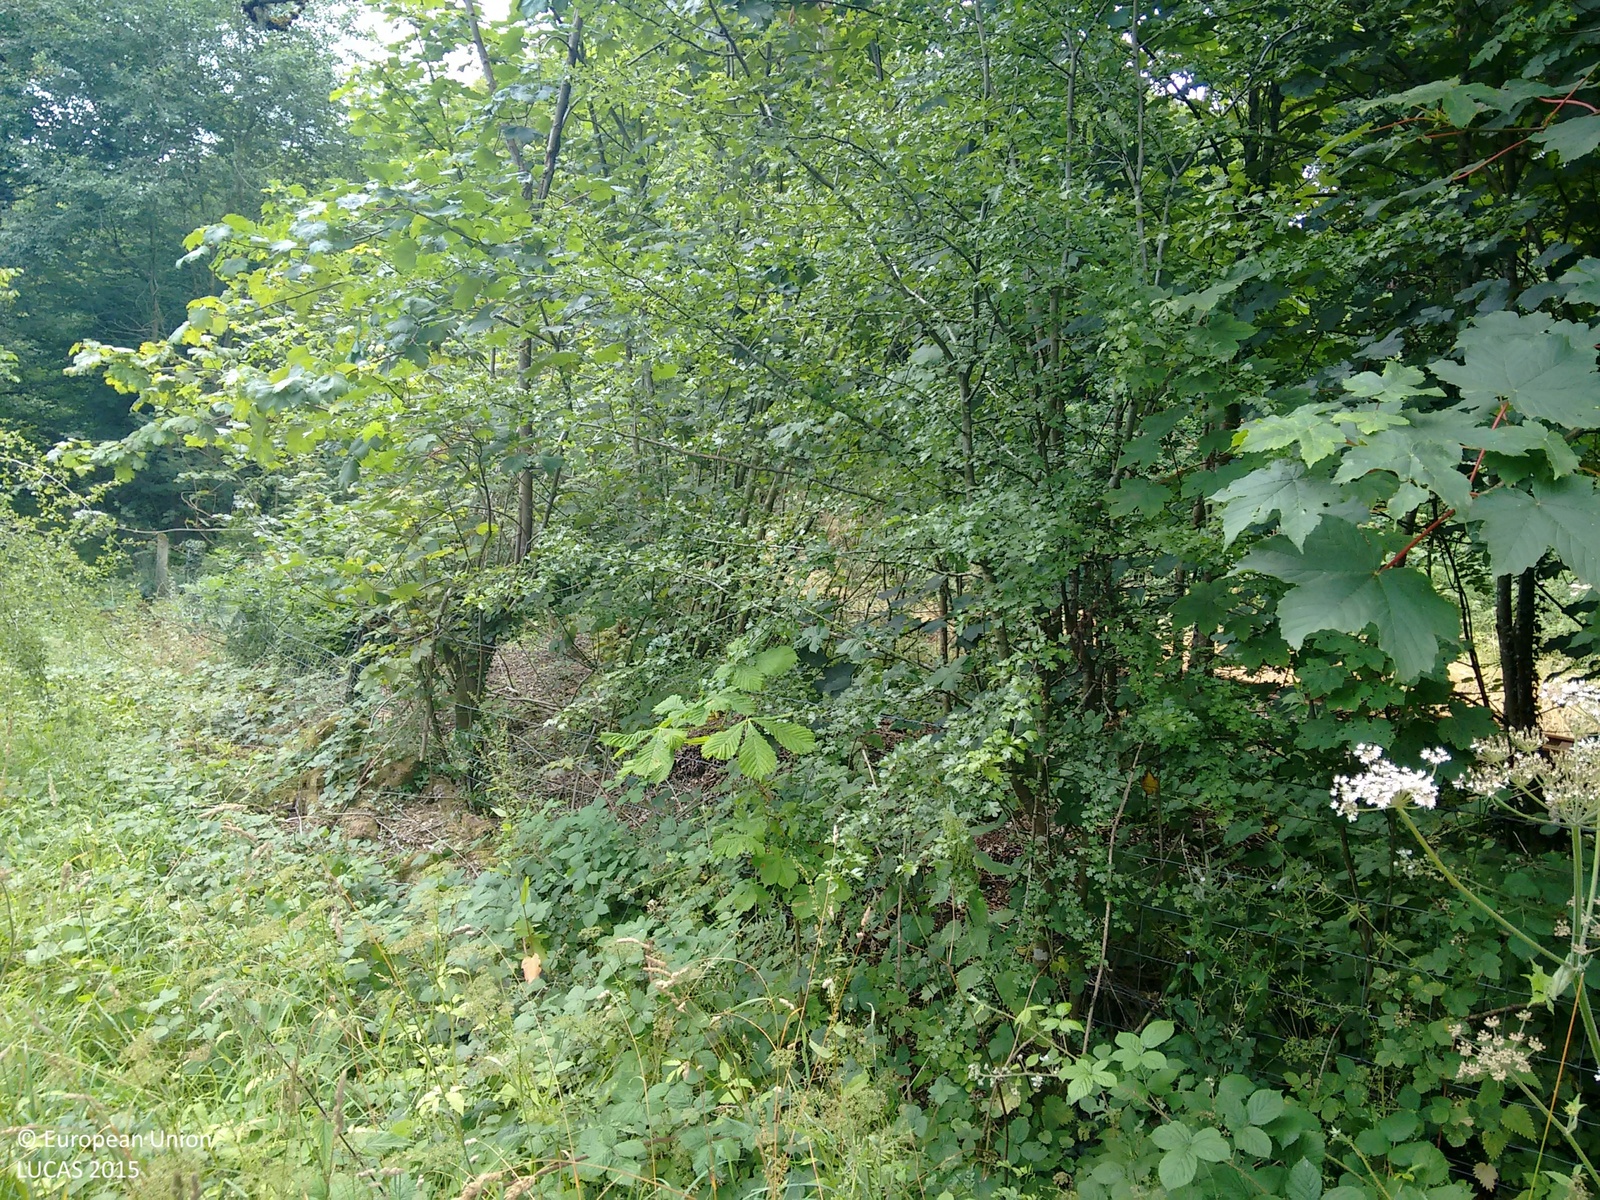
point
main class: Woodland
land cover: Broadleaved woodland
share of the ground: > 75 %
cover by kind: broadleaved forest trees 100 %
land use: Semi-natural and natural areas not in use
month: July
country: GB
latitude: 51.8717
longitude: -3.9942
